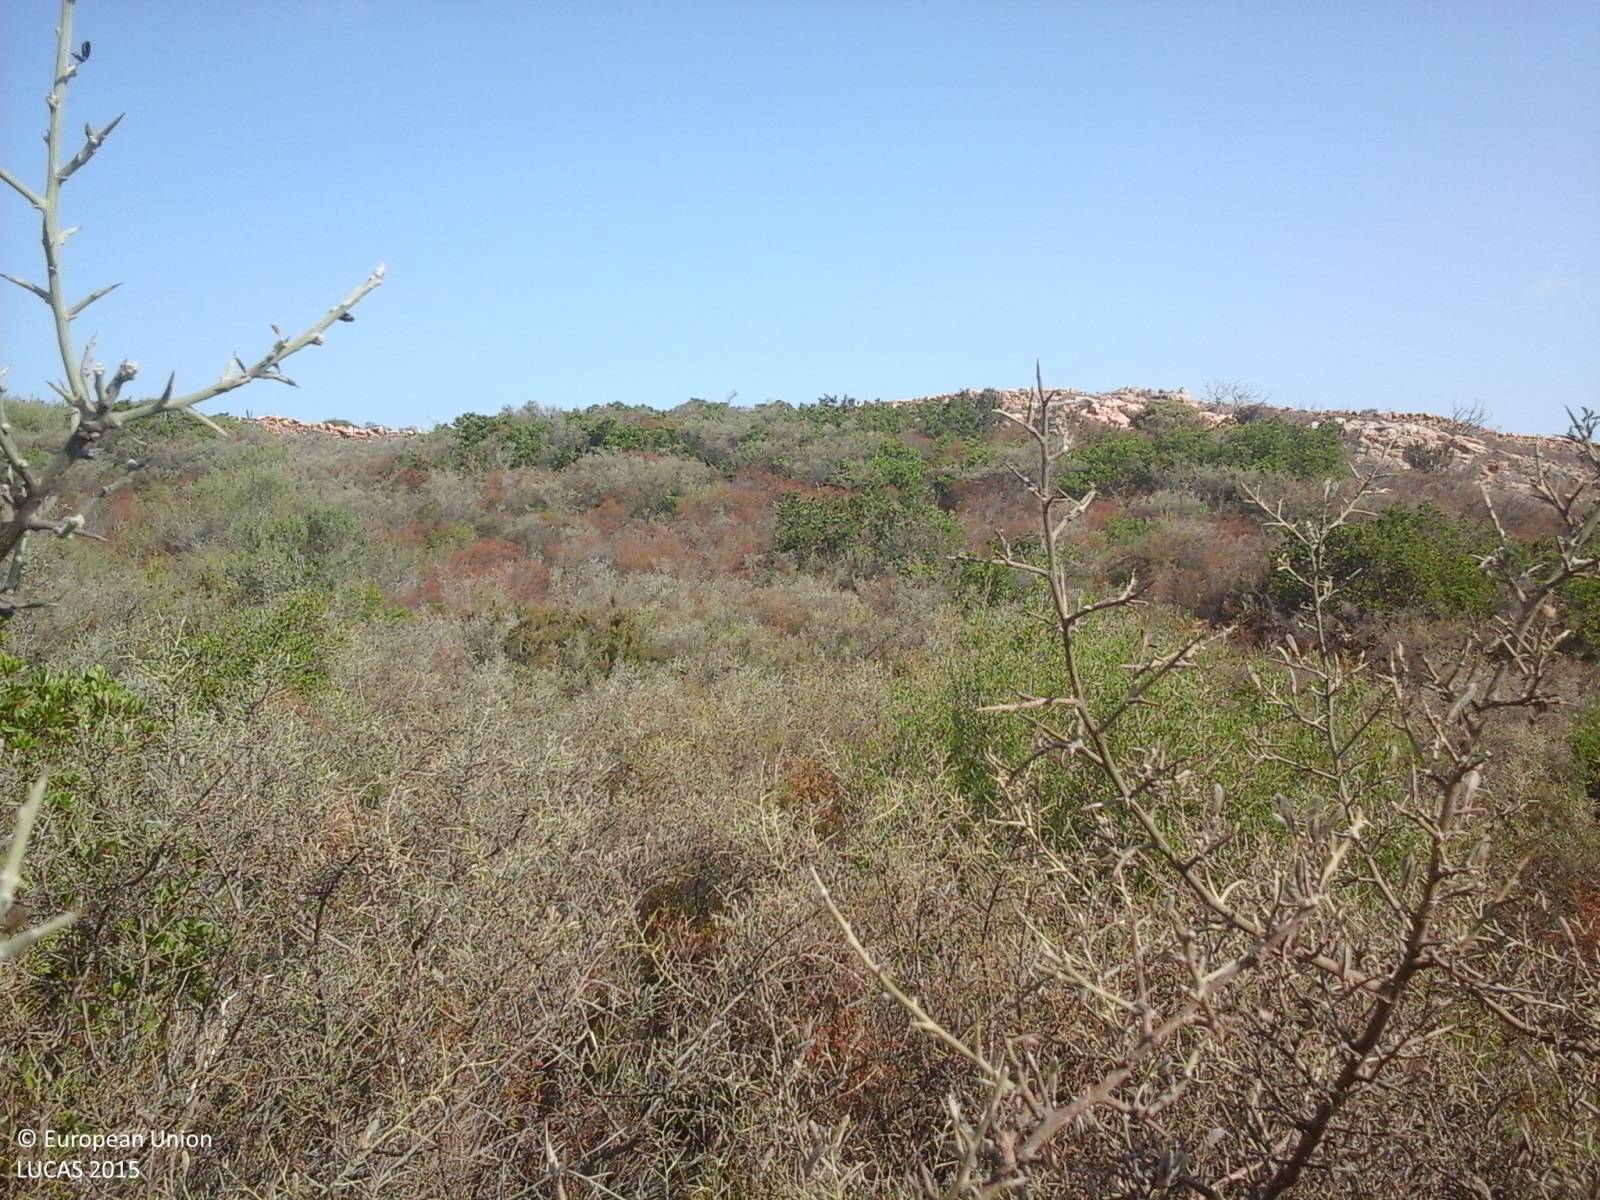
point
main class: Shrubland
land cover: Shrubland without tree cover
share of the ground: > 75 %
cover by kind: shrubs 95 %, unconsolidated bare surface 5 %
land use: Semi-natural and natural areas not in use
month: July
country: IT
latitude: 40.8638
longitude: 9.6340
